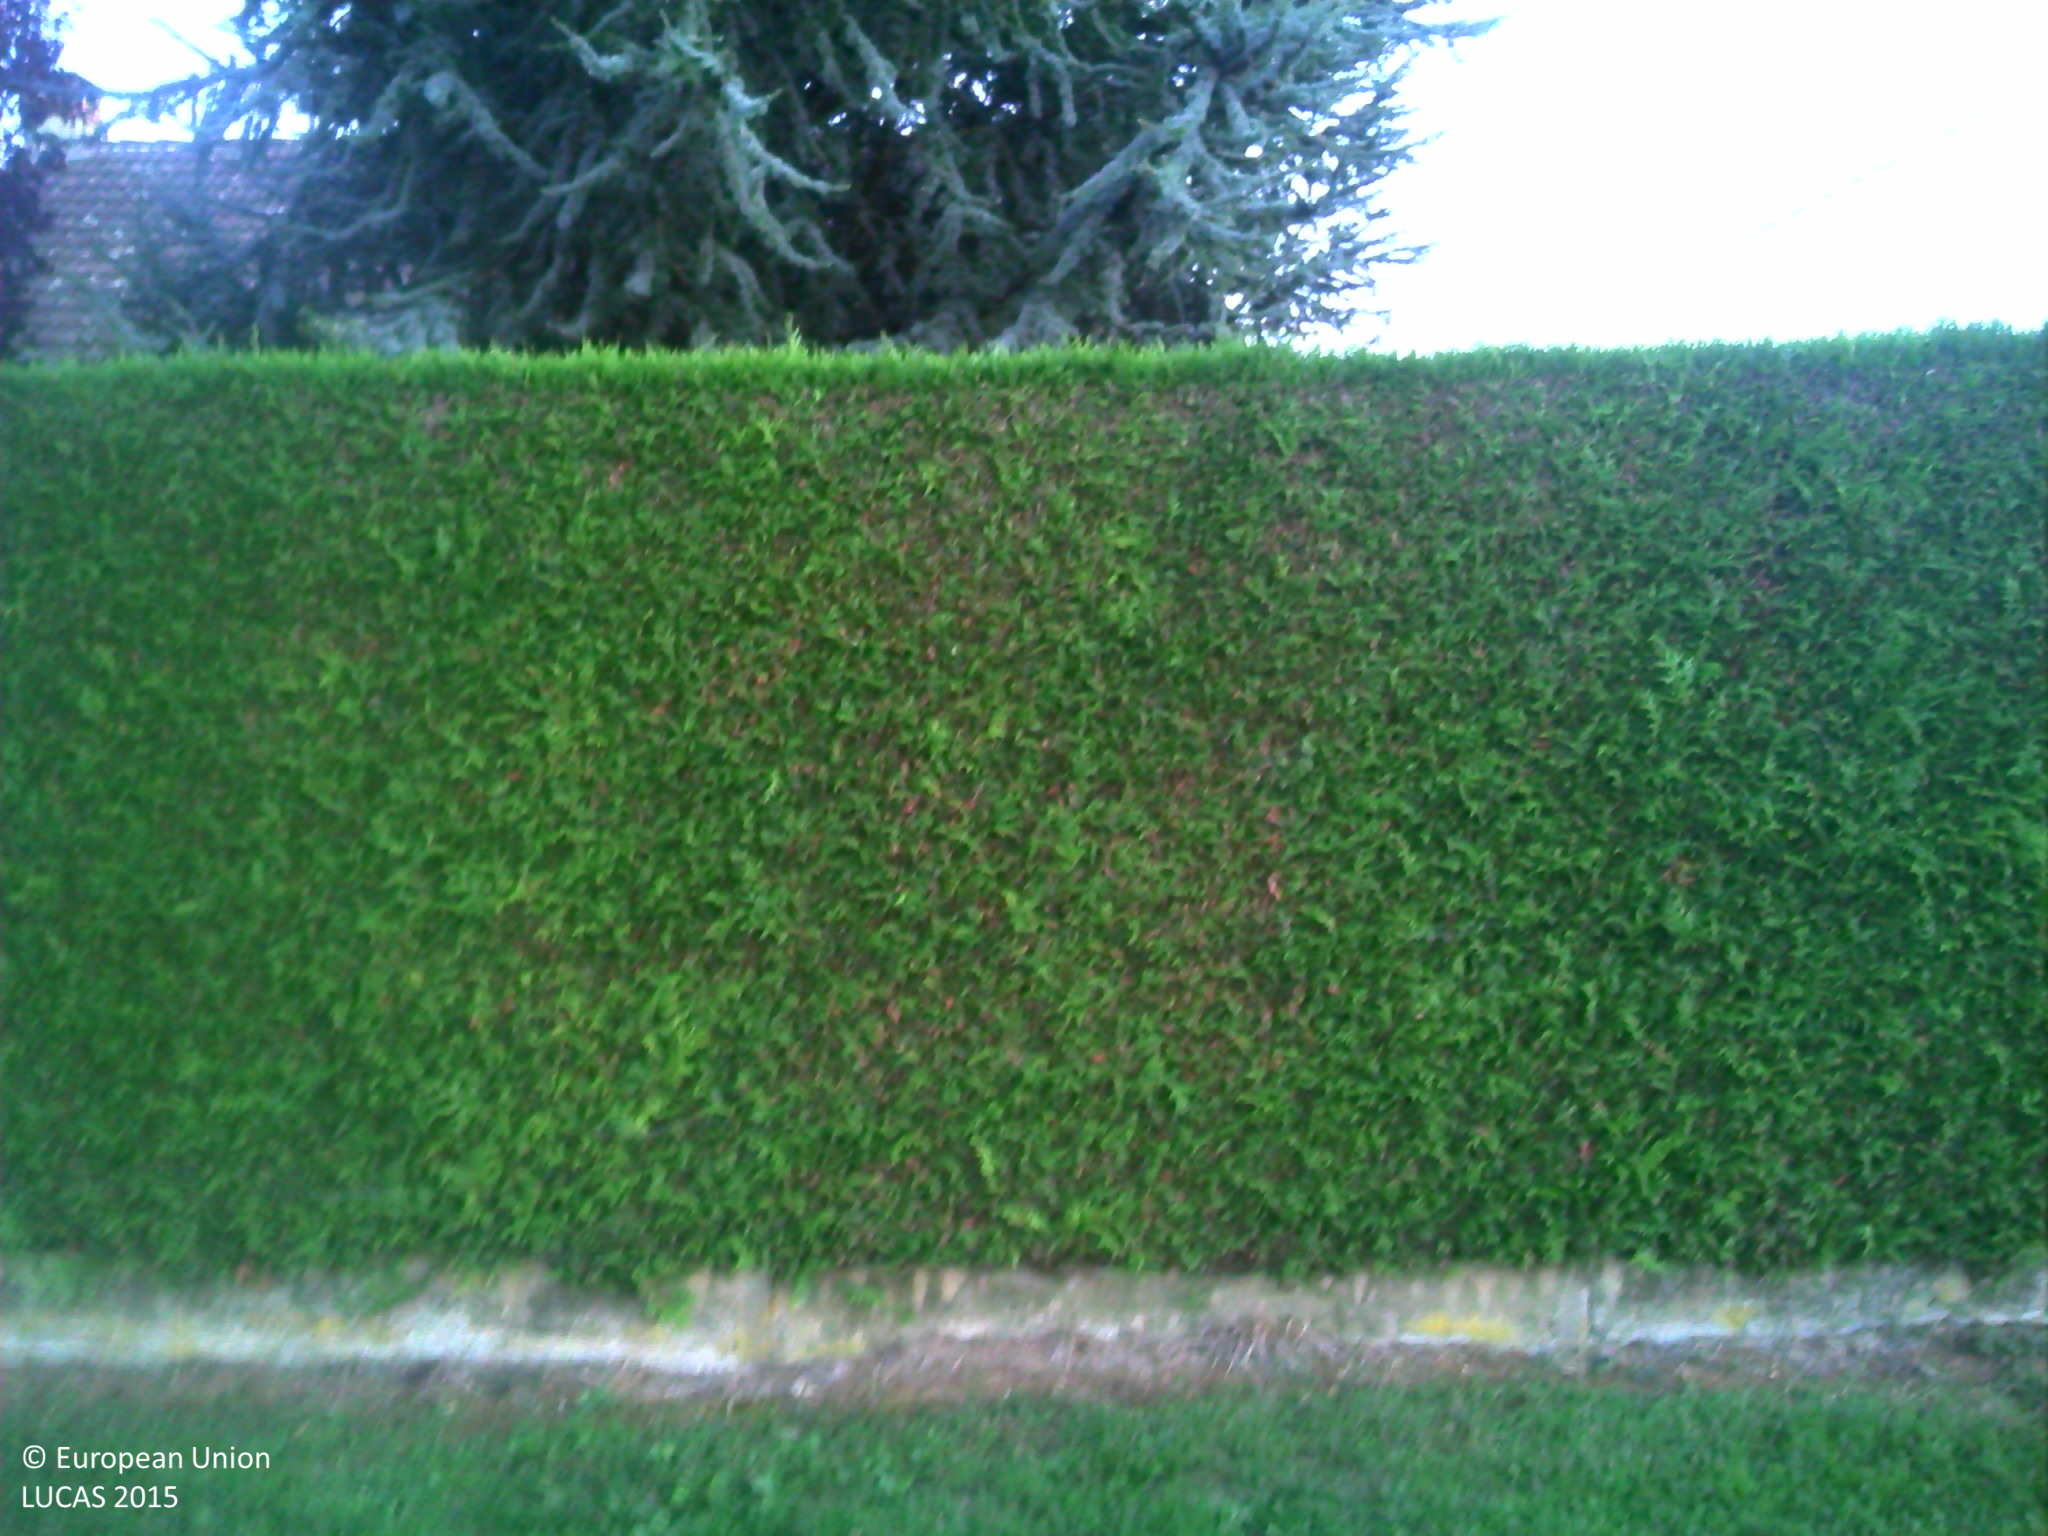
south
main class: Grassland
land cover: Grassland with sparse tree/shrub cover
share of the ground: > 75 %
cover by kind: herbaceous plants 95 %, broadleaved forest trees 5 %
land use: Residential
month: September
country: FR
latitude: 48.3751
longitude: 0.5117
